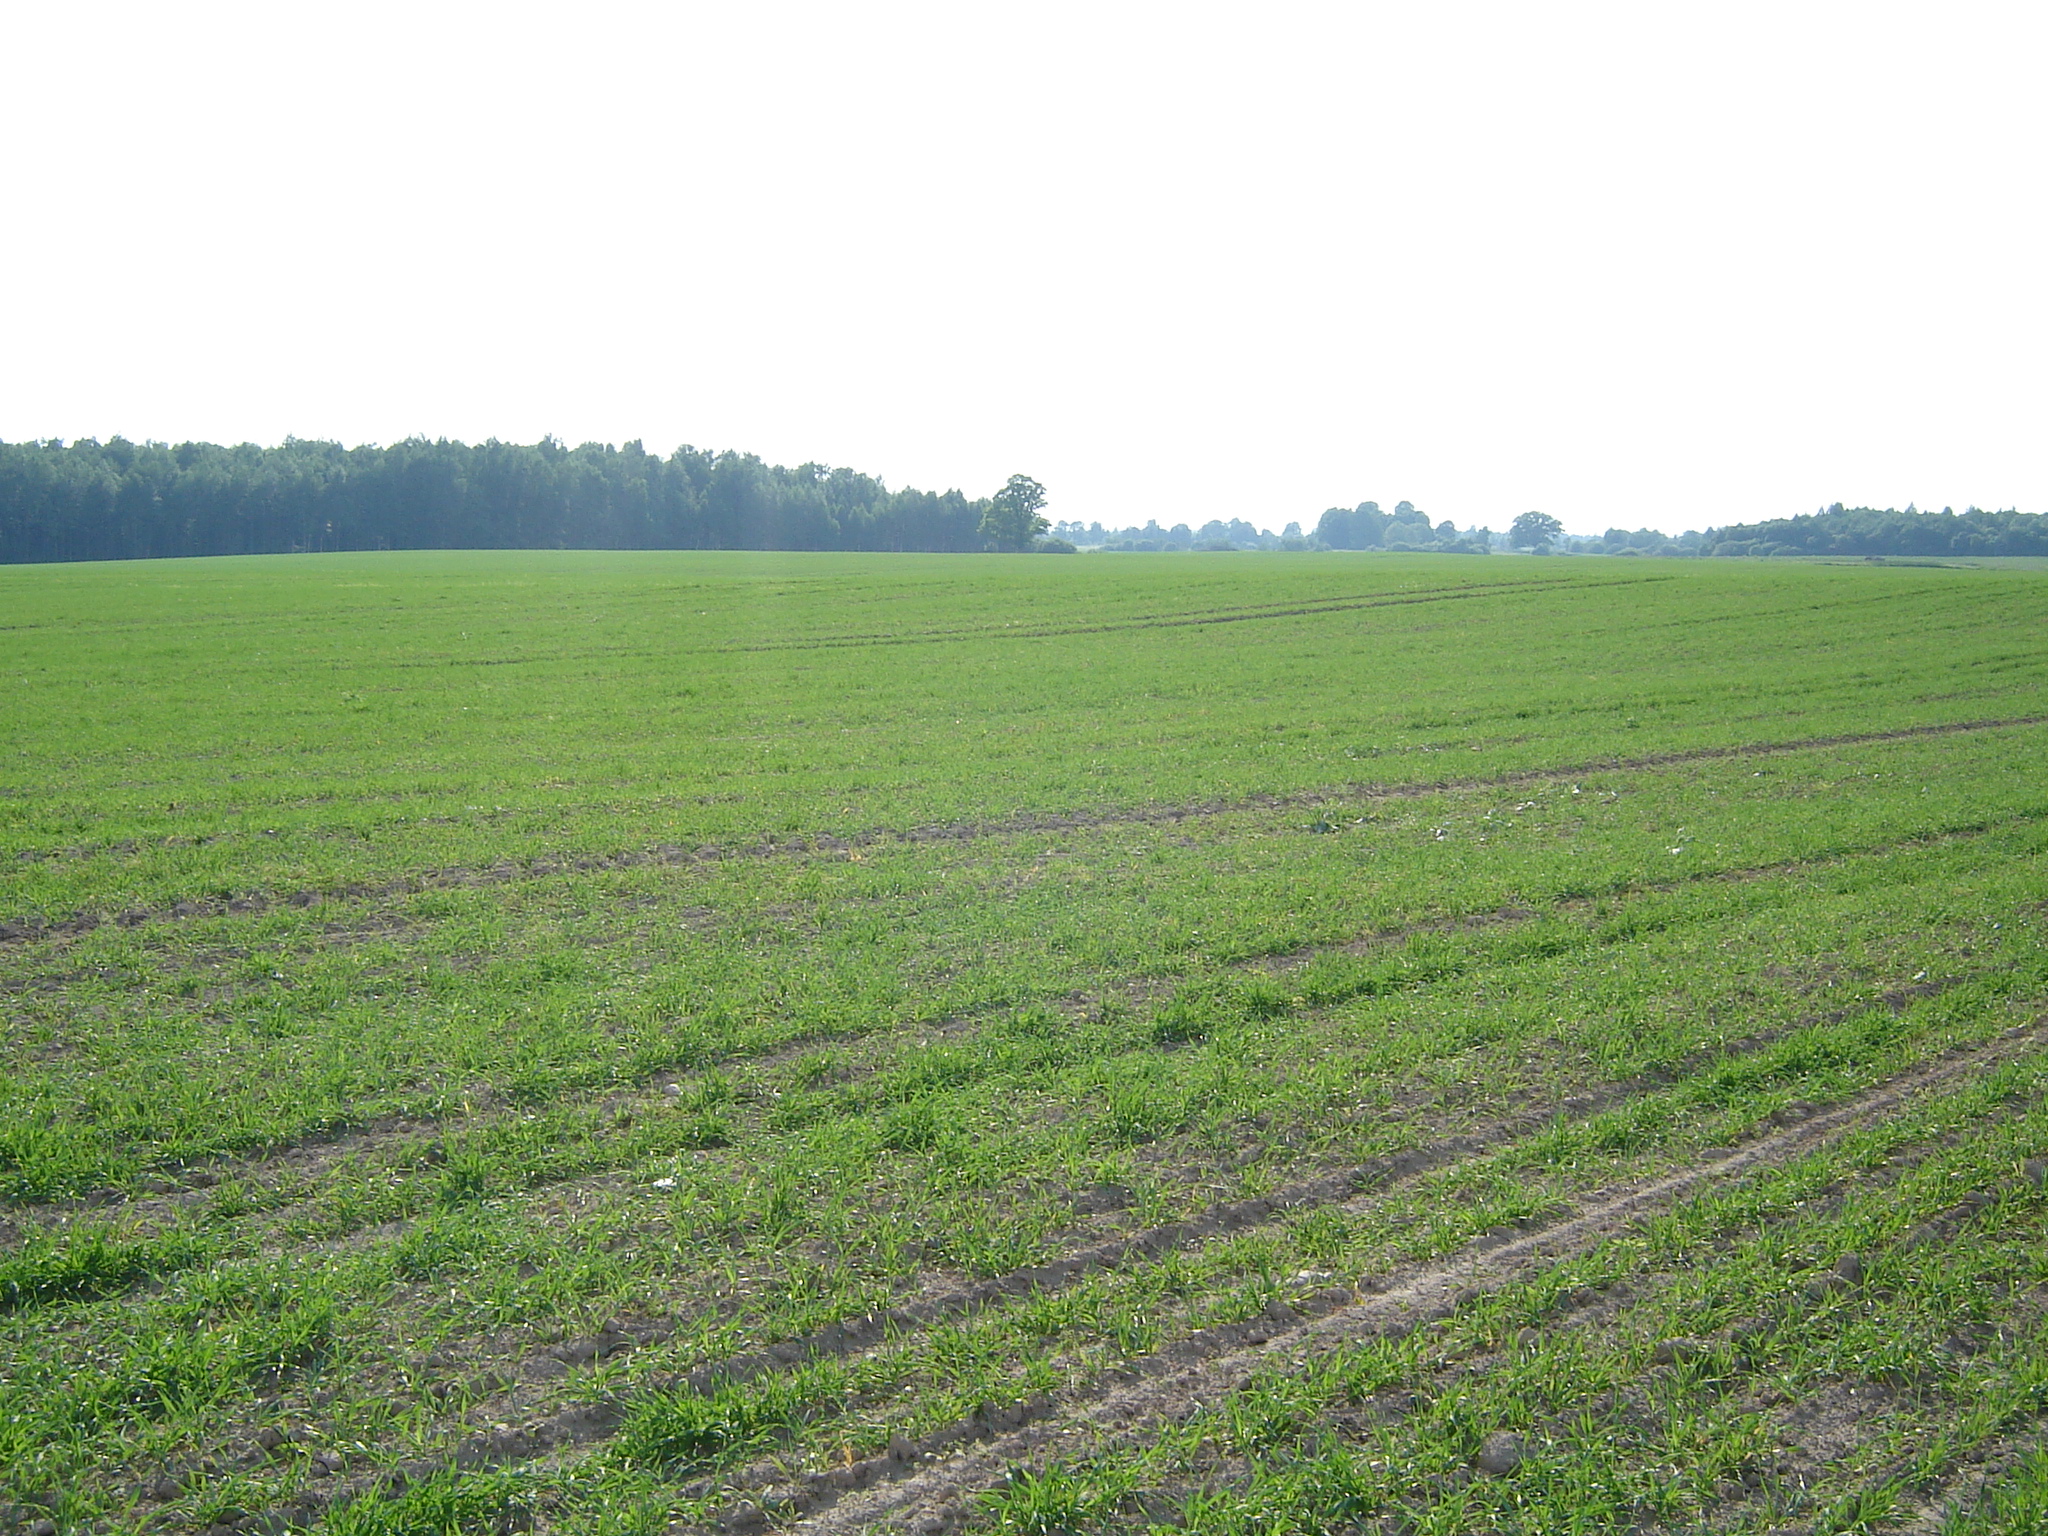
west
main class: Cropland
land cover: Barley
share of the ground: 50 - 75 %
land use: Agriculture (excluding fallow land and kitchen gardens)
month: June
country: LT
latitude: 55.8733
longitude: 25.2519
